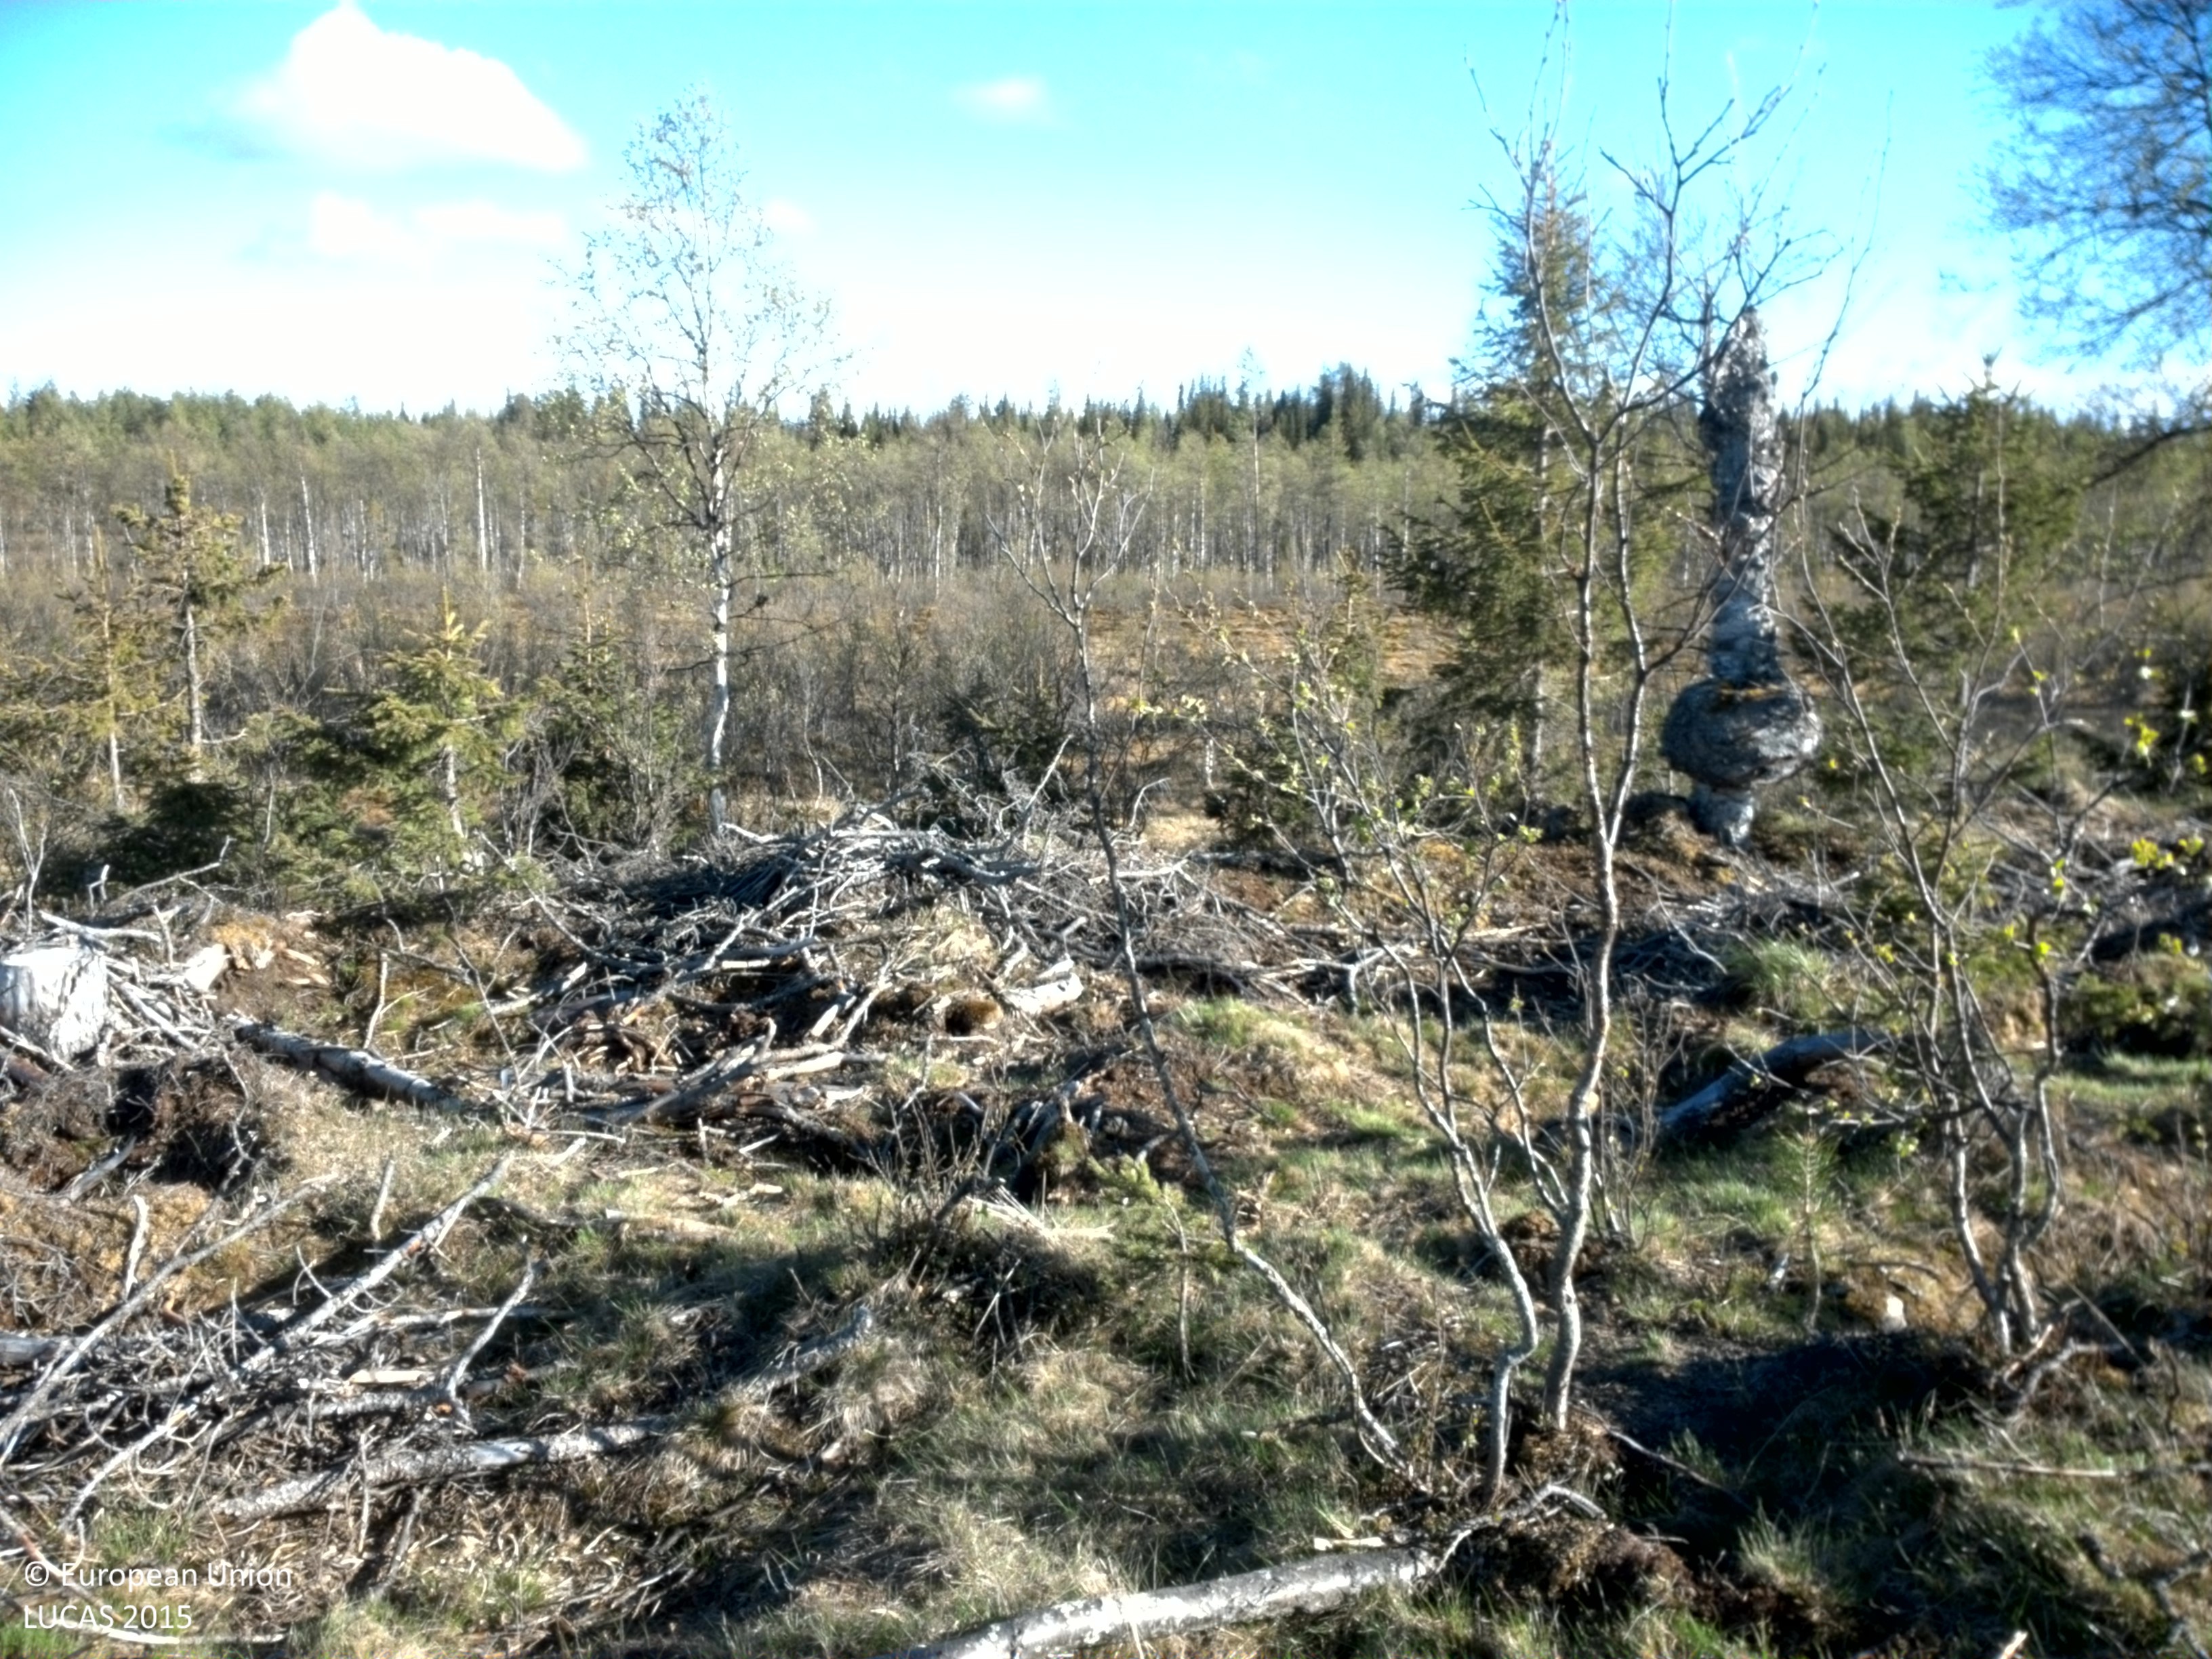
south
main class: Grassland
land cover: Grassland with sparse tree/shrub cover
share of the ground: > 75 %
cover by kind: herbaceous plants 80 %, coniferous forest trees 5 %, shrubs 5 %, lichens and mosses 5 %, unconsolidated bare surface 5 %
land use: Forestry
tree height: > 5 m
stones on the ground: < 10 %
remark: Clear cut
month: June
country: SE
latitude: 66.8708
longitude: 21.2488
